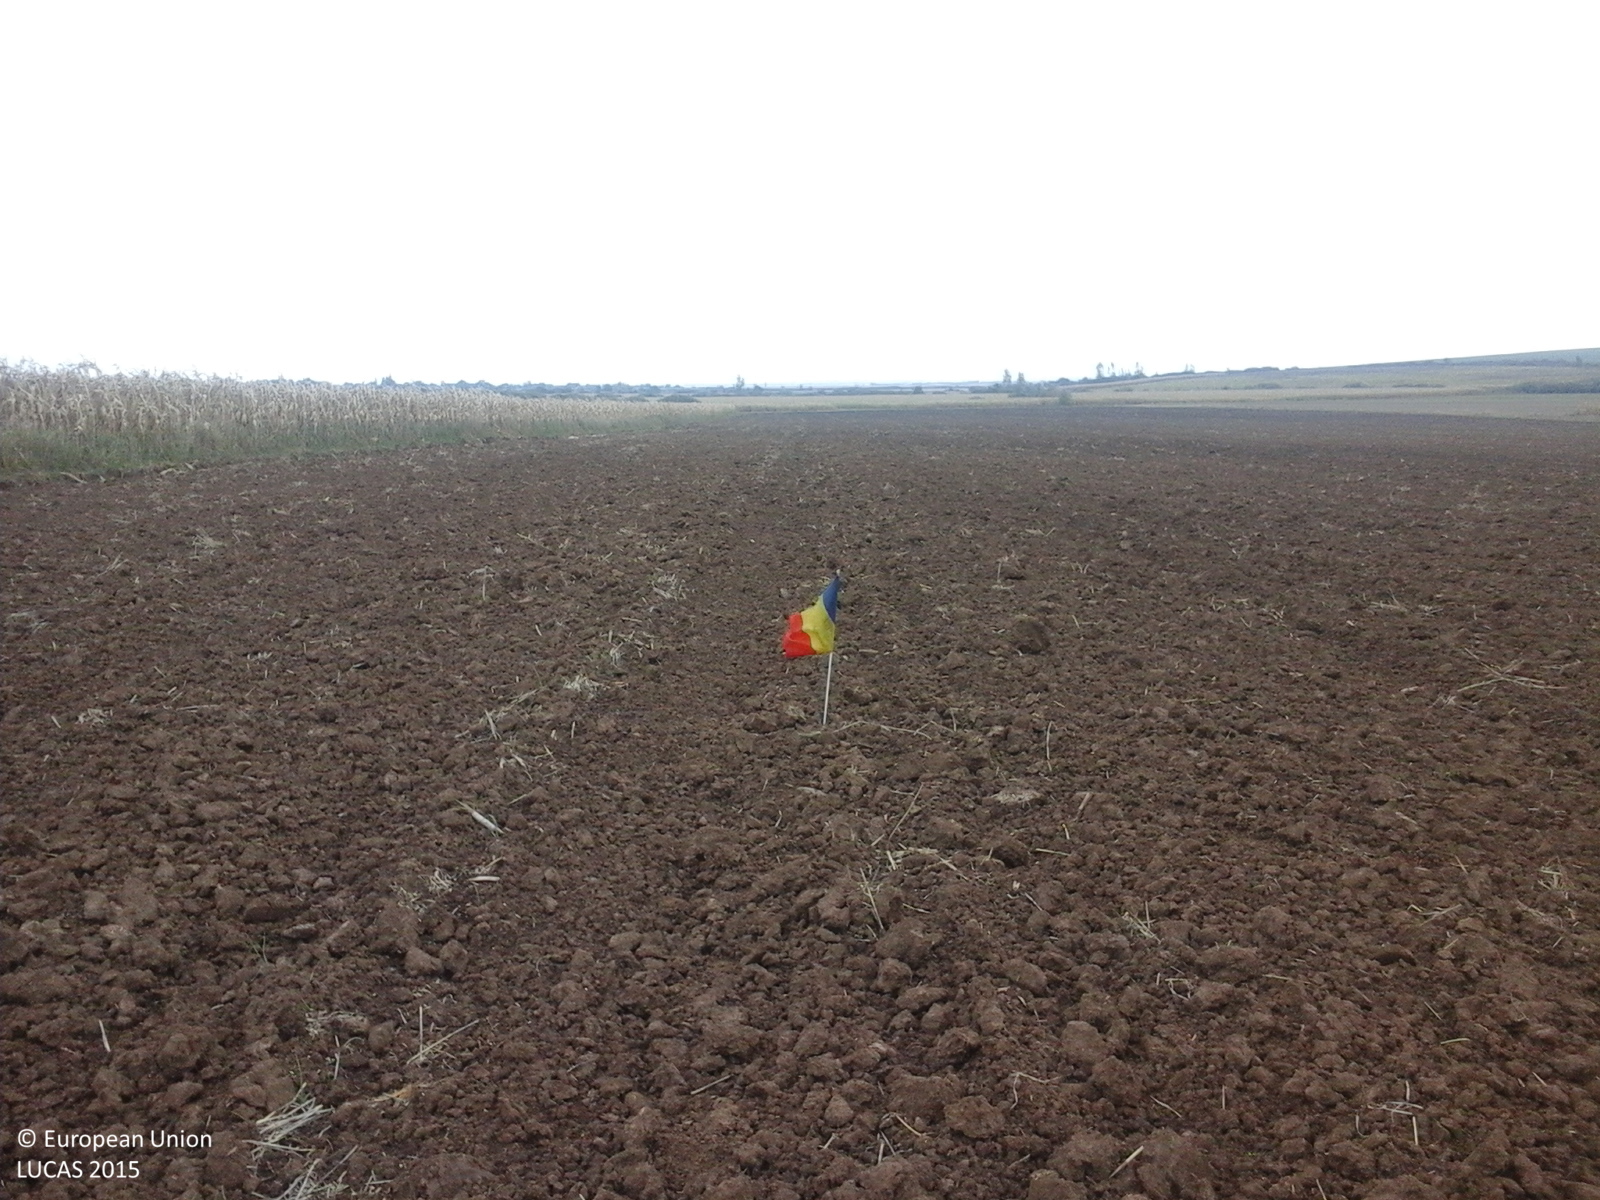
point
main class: Cropland
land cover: Common wheat
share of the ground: < 10 %
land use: Agriculture (excluding fallow land and kitchen gardens)
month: September
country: RO
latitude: 47.4766
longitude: 22.4631
